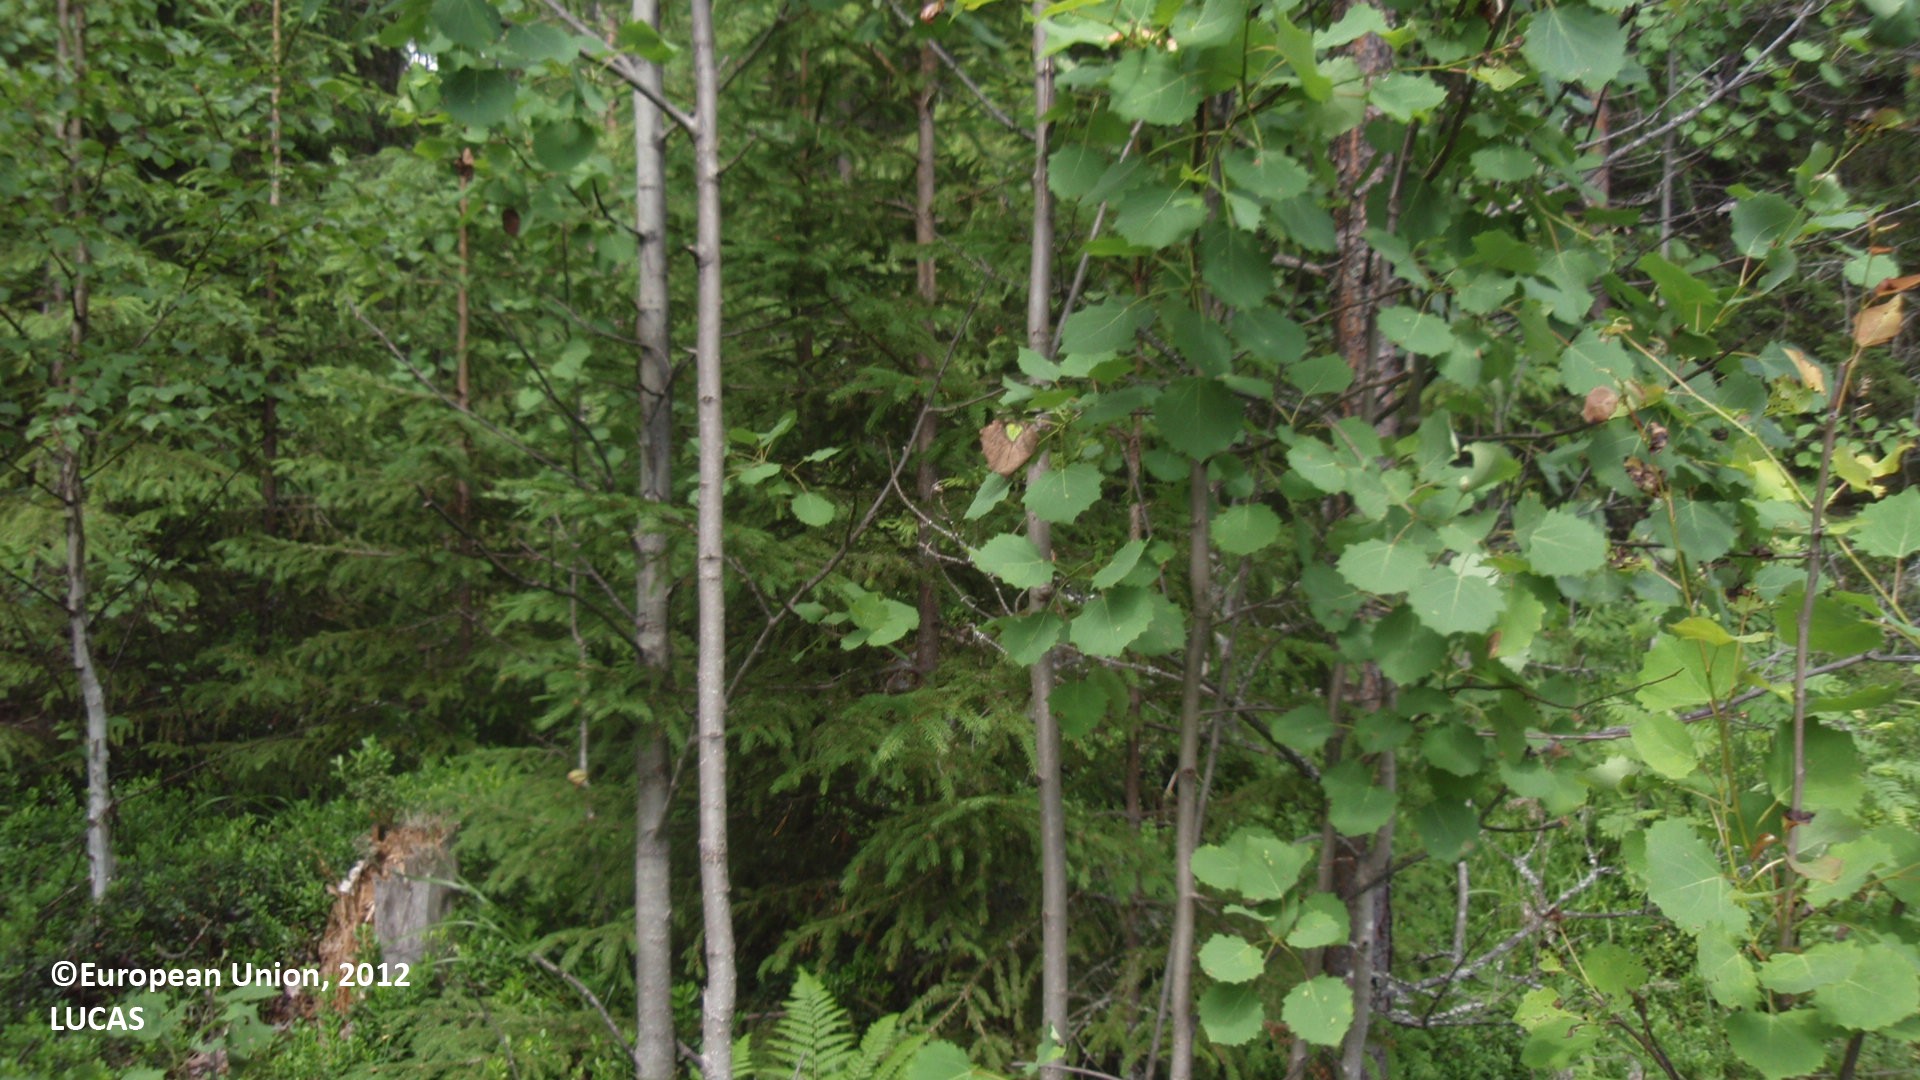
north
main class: Woodland
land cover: Spruce dominated mixed woodland
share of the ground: 25 - 50 %
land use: Forestry
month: July
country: FI
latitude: 61.7039
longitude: 28.1040
